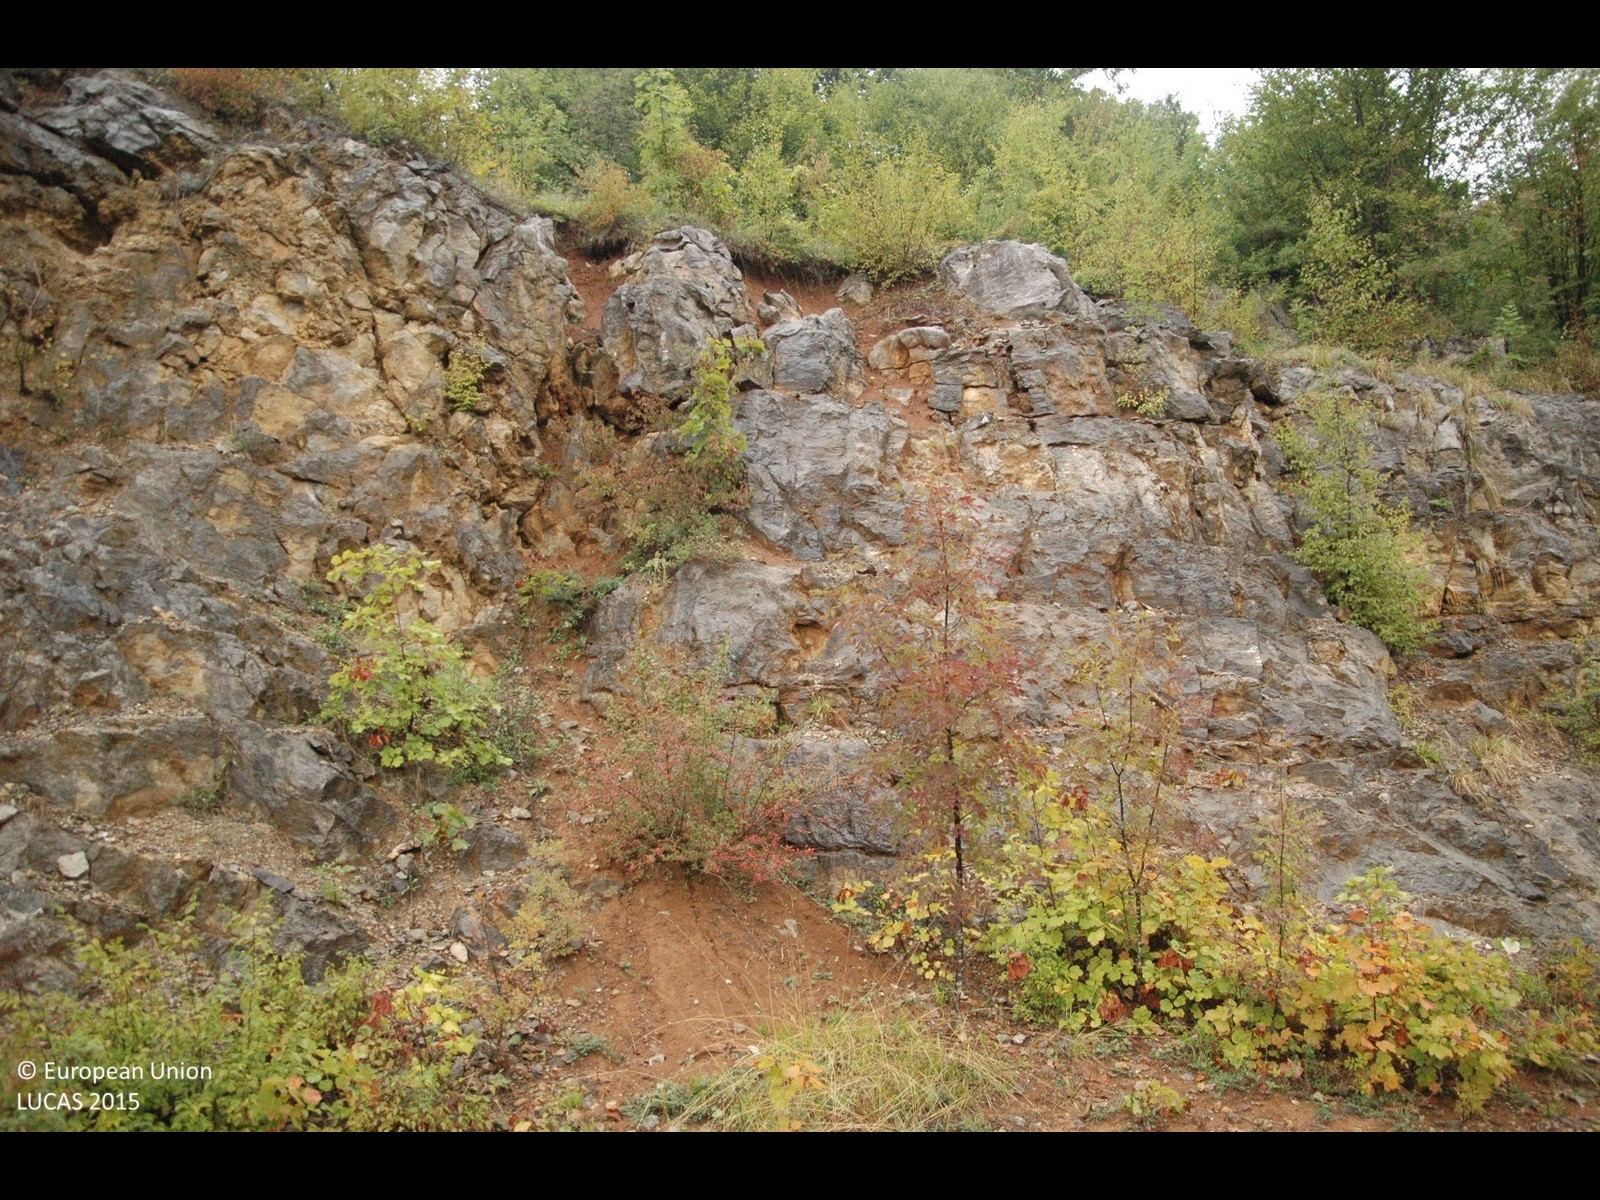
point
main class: Woodland
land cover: Broadleaved woodland
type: beech forest
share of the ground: > 75 %
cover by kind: broadleaved forest trees 100 %
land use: Forestry
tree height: > 5 m
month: October
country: HR
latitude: 45.1739
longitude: 15.2757
